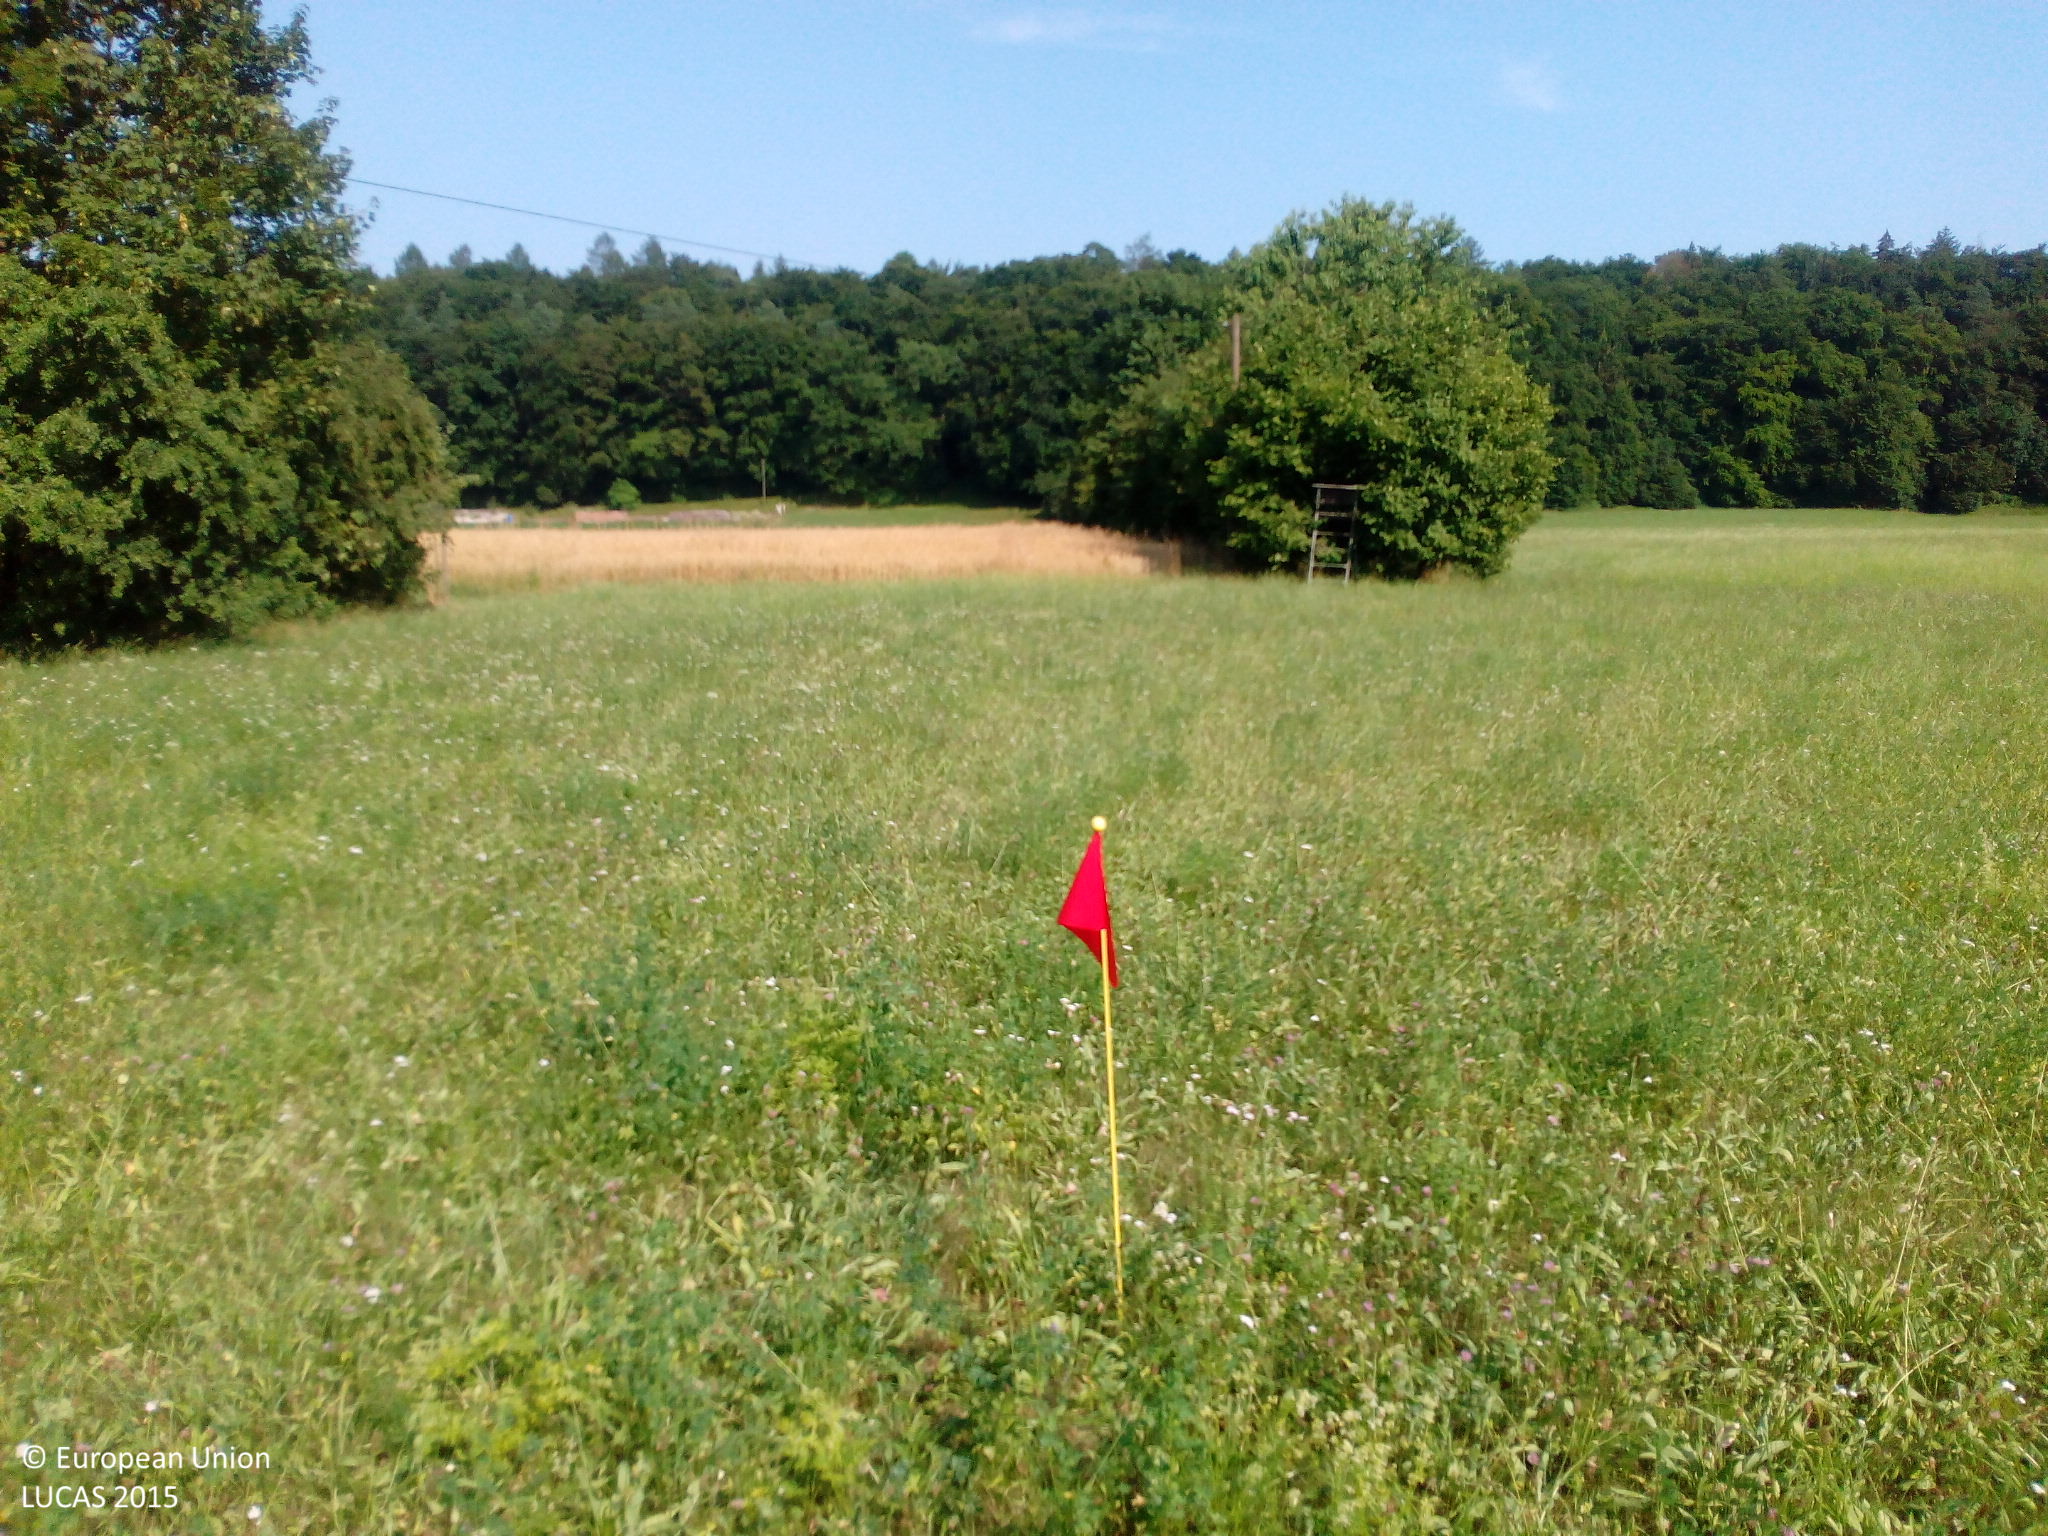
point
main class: Grassland
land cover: Grassland without tree/shrub cover
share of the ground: > 75 %
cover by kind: herbaceous plants 100 %
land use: Agriculture (excluding fallow land and kitchen gardens)
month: July
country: DE
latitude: 48.2237
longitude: 12.8123
